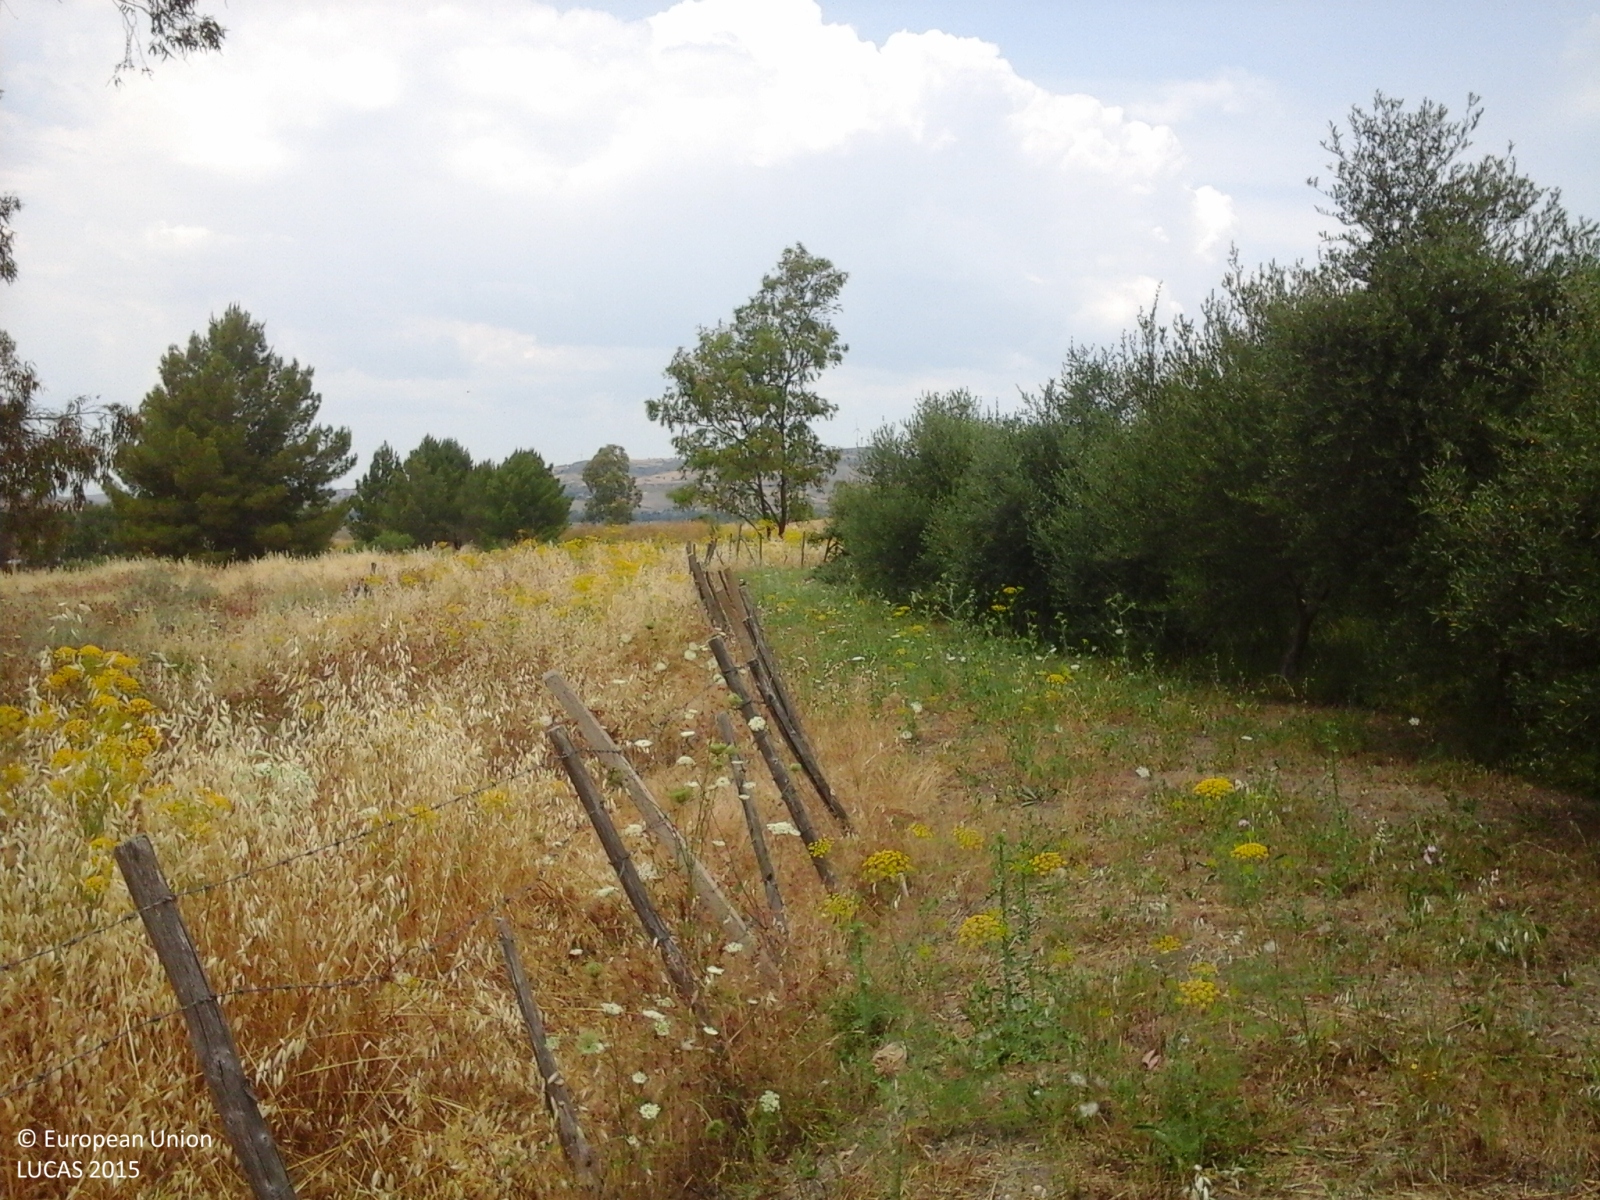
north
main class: Woodland
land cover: Broadleaved woodland
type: exotic forest
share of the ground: 50 - 75 %
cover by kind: broadleaved forest trees 100 %
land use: Forestry
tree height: > 5 m
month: June
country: IT
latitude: 37.4197
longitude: 14.5650
